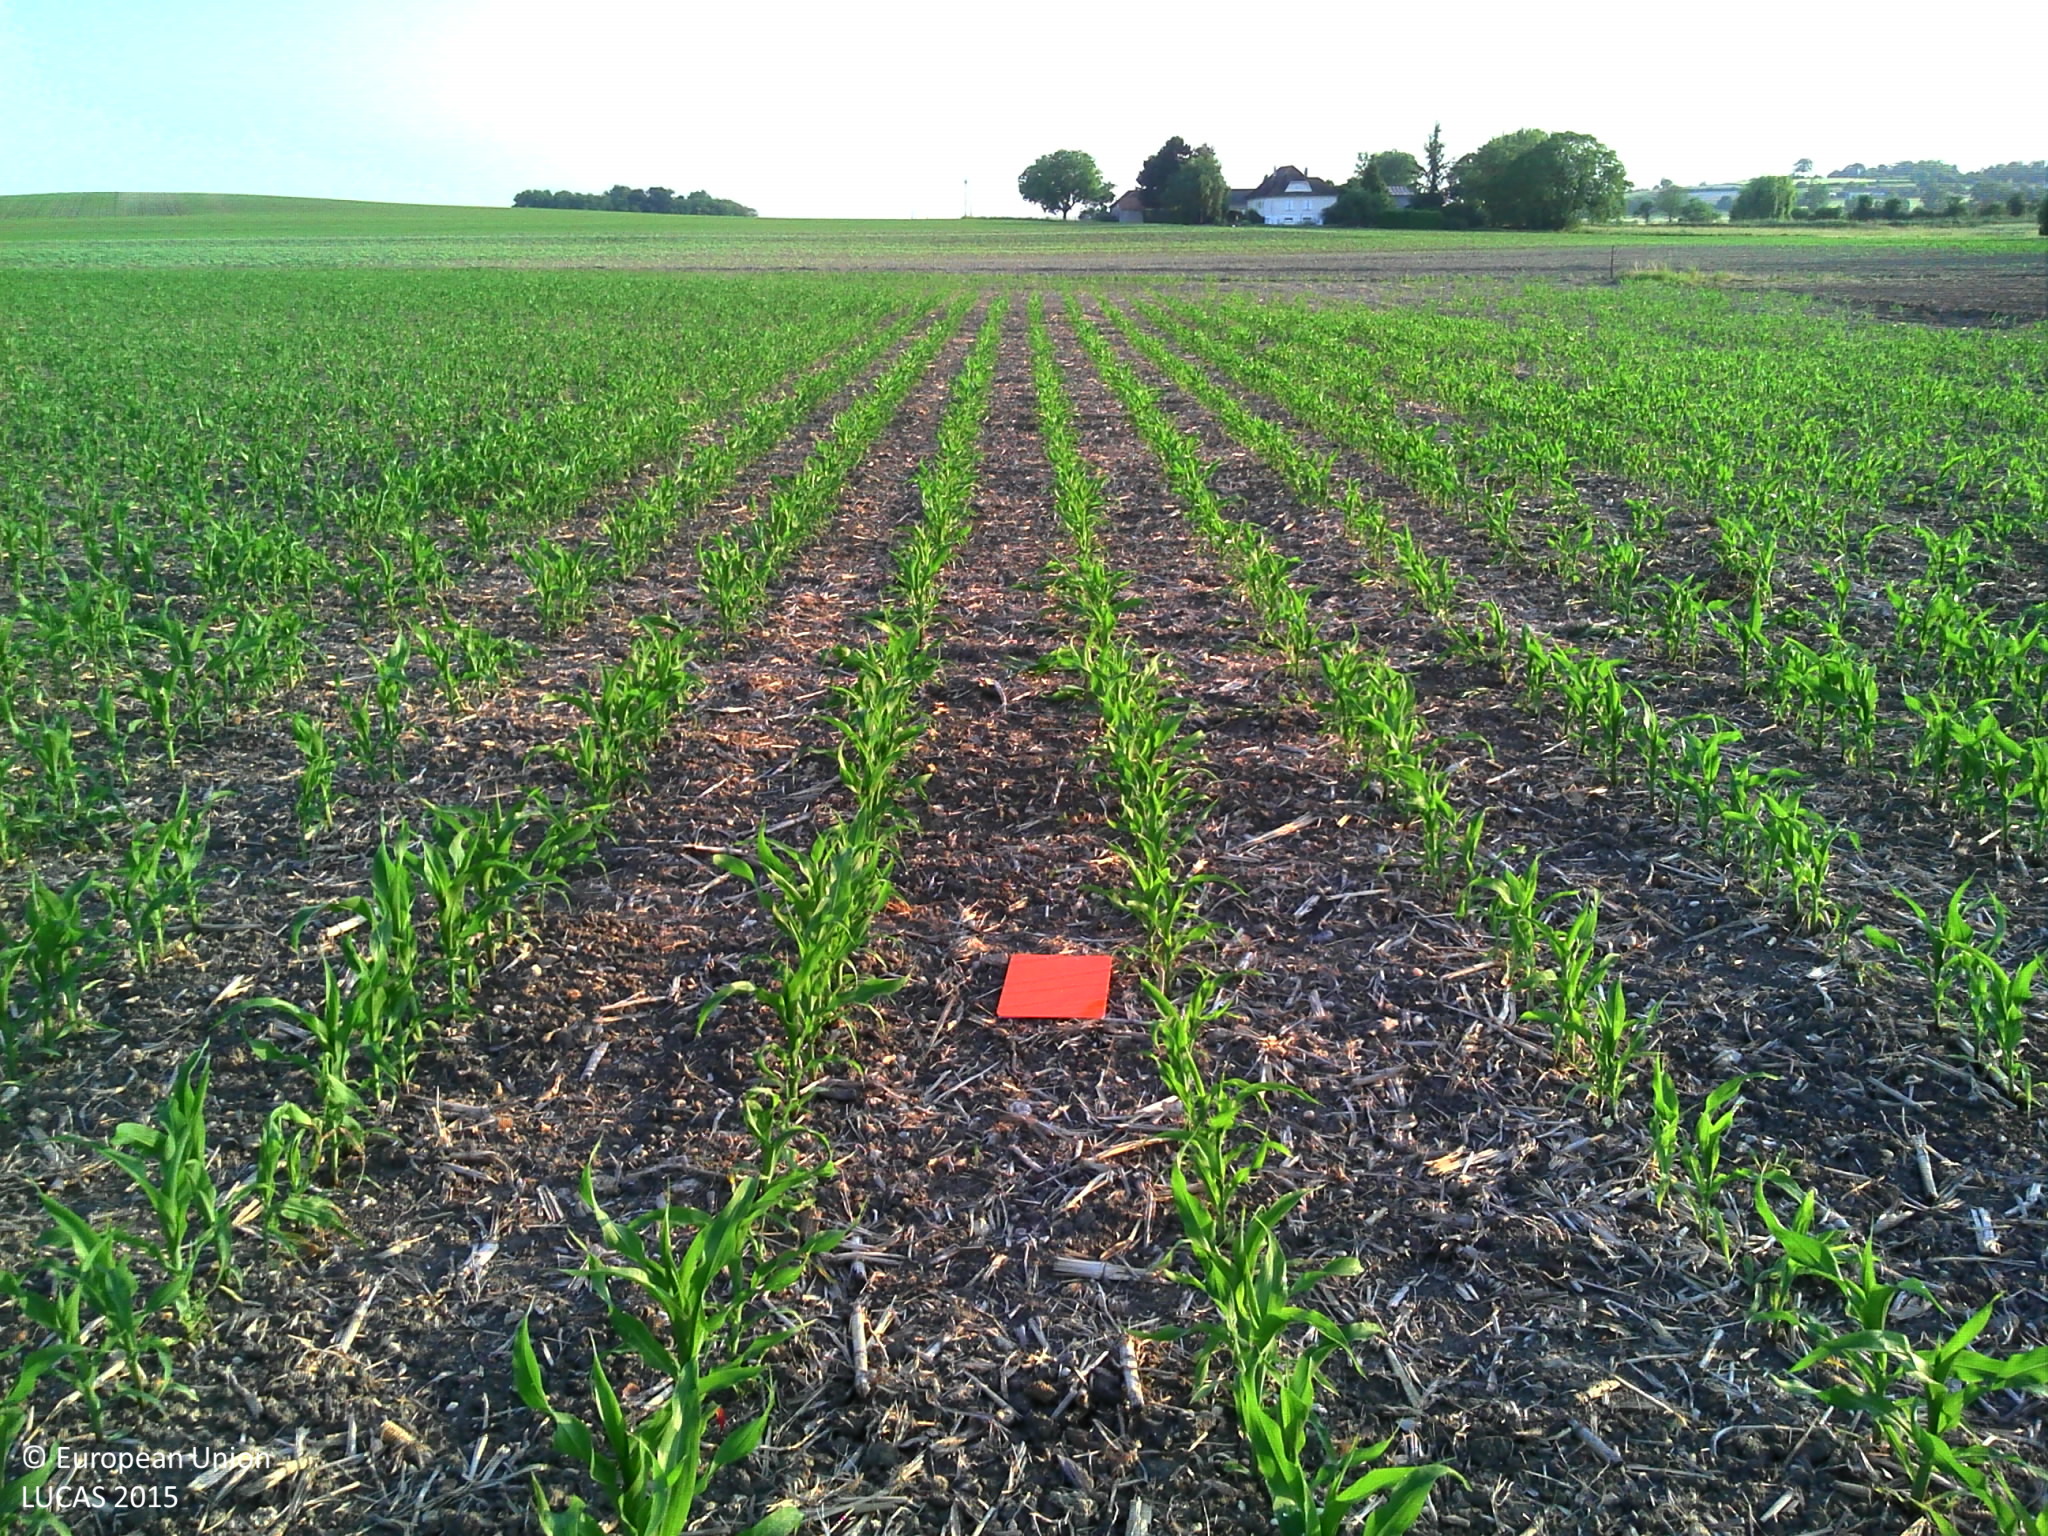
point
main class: Cropland
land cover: Maize
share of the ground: 25 - 50 %
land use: Agriculture (excluding fallow land and kitchen gardens)
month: June
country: FR
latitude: 46.7852
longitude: 0.5639
